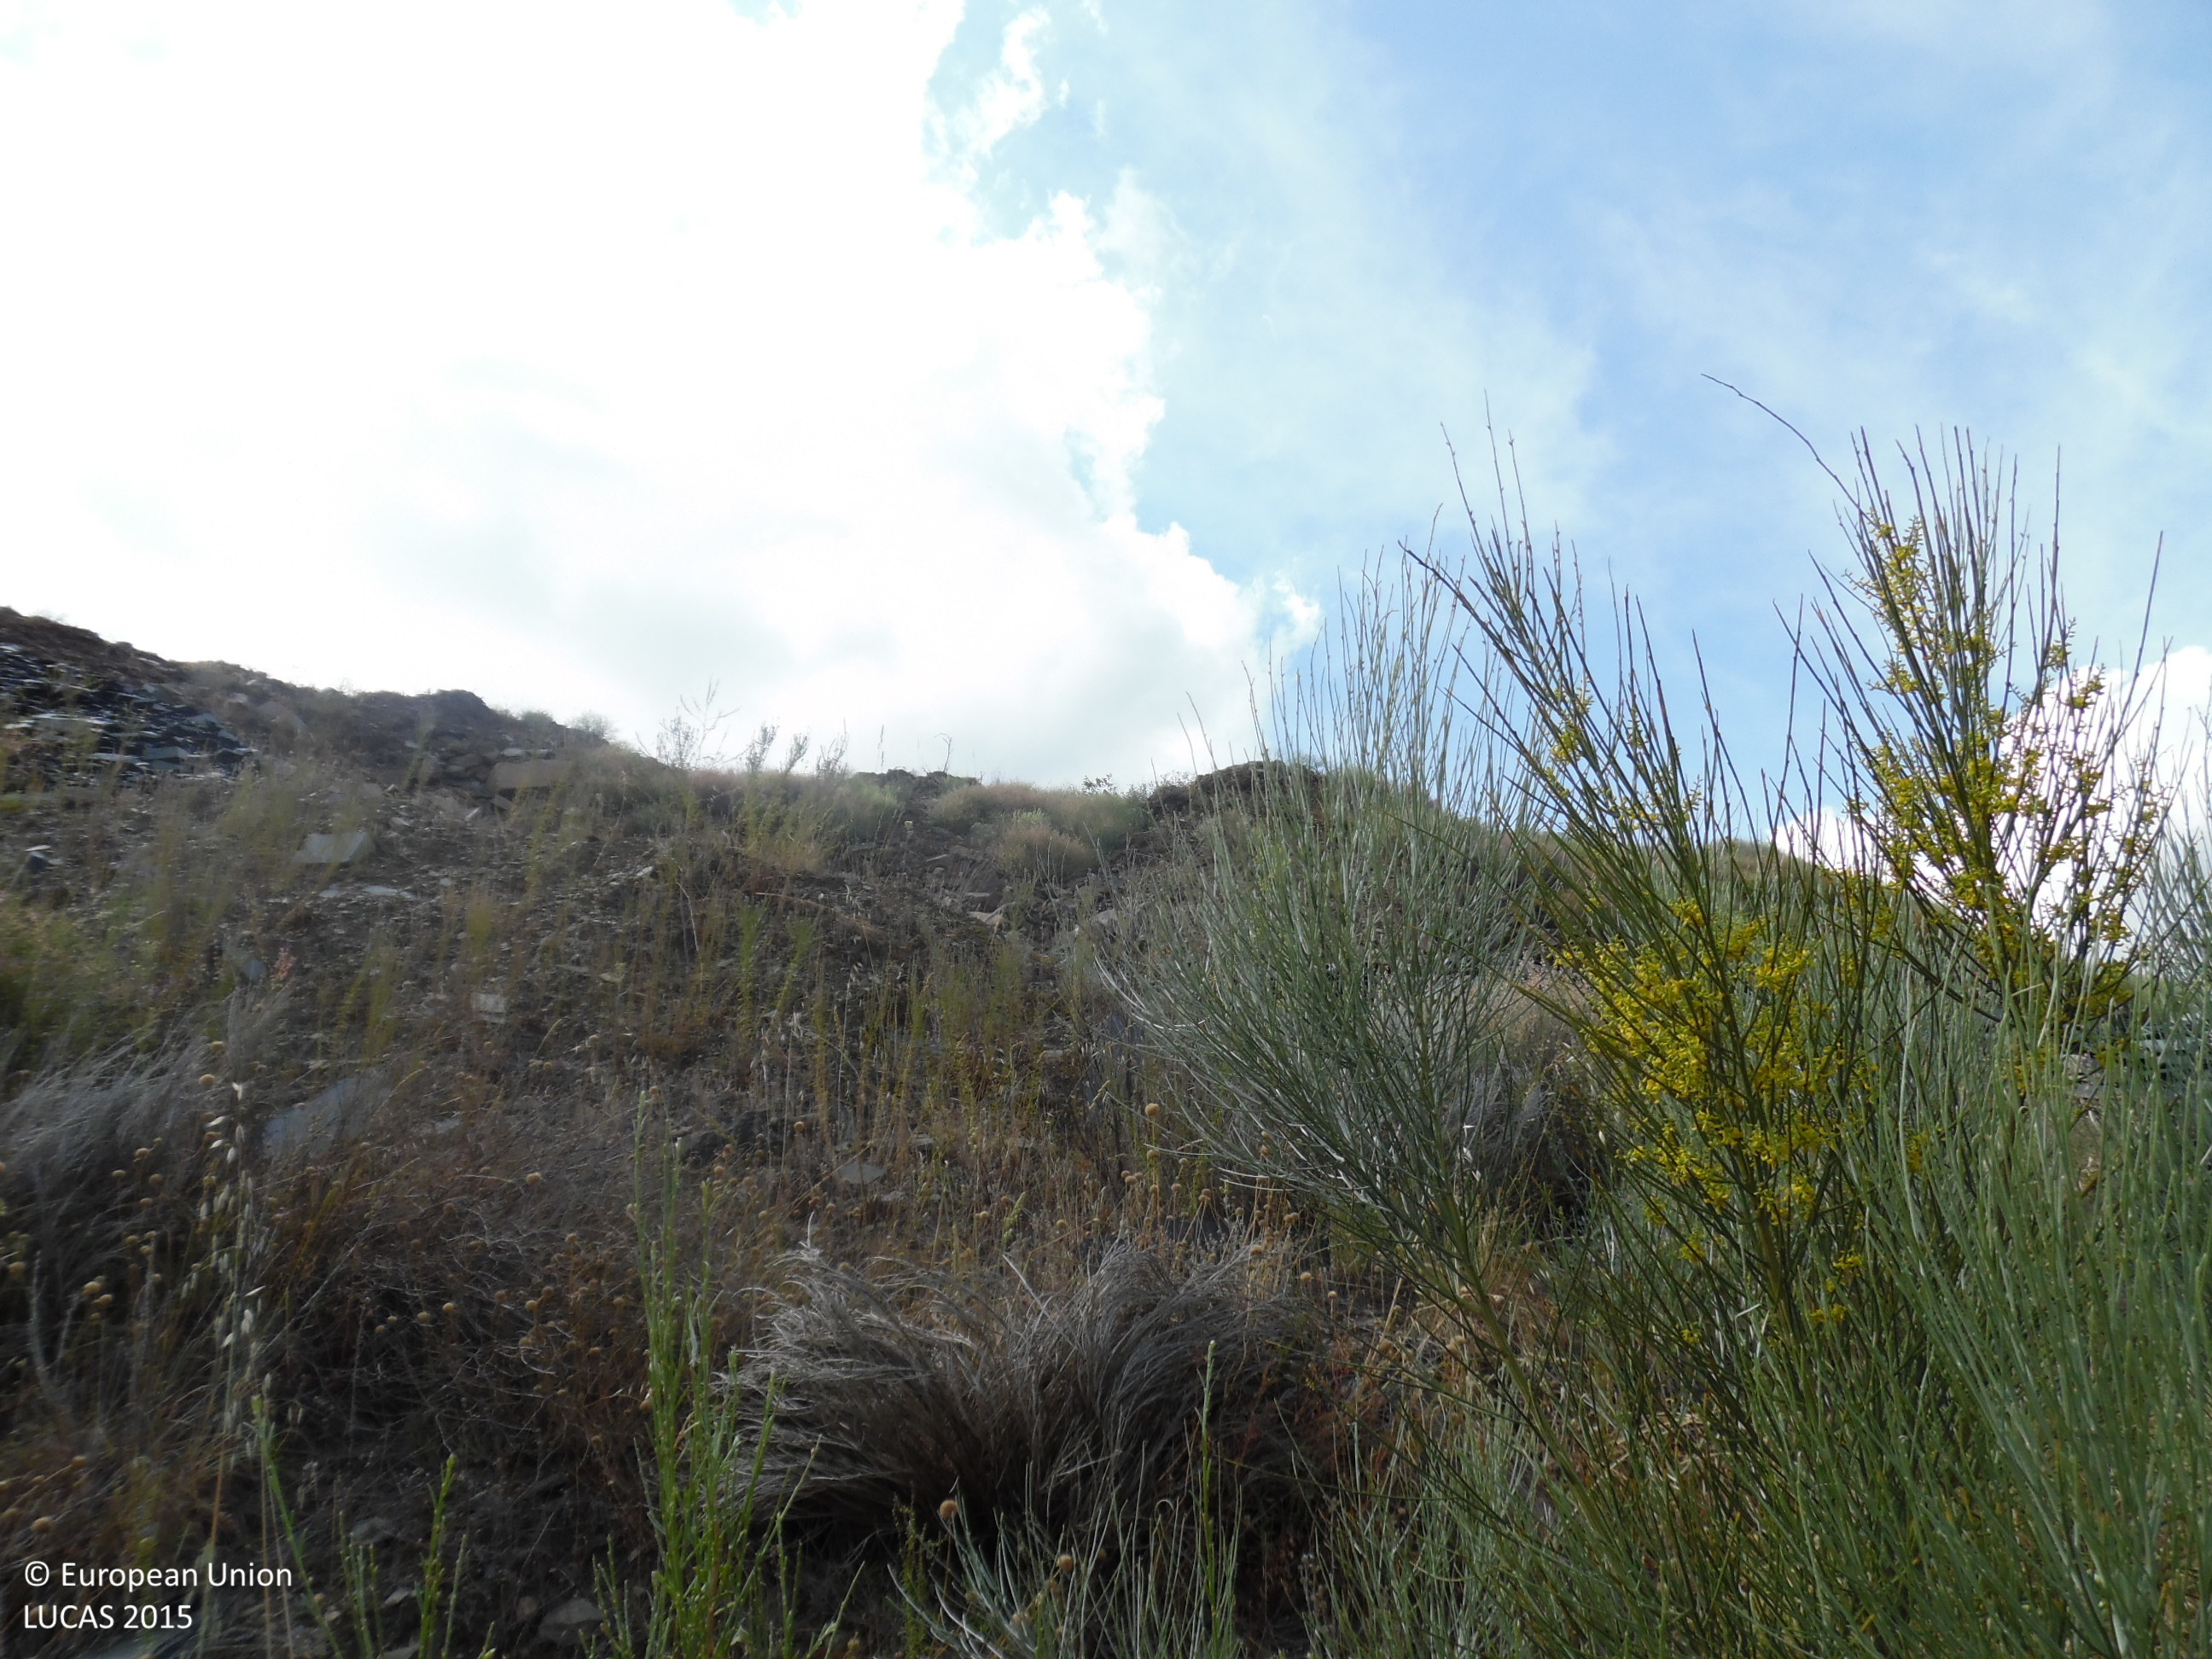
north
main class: Shrubland
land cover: Shrubland without tree cover
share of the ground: > 75 %
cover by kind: shrubs 100 %
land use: Abandoned areas
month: June
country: ES
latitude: 42.4140
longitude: -6.7078
